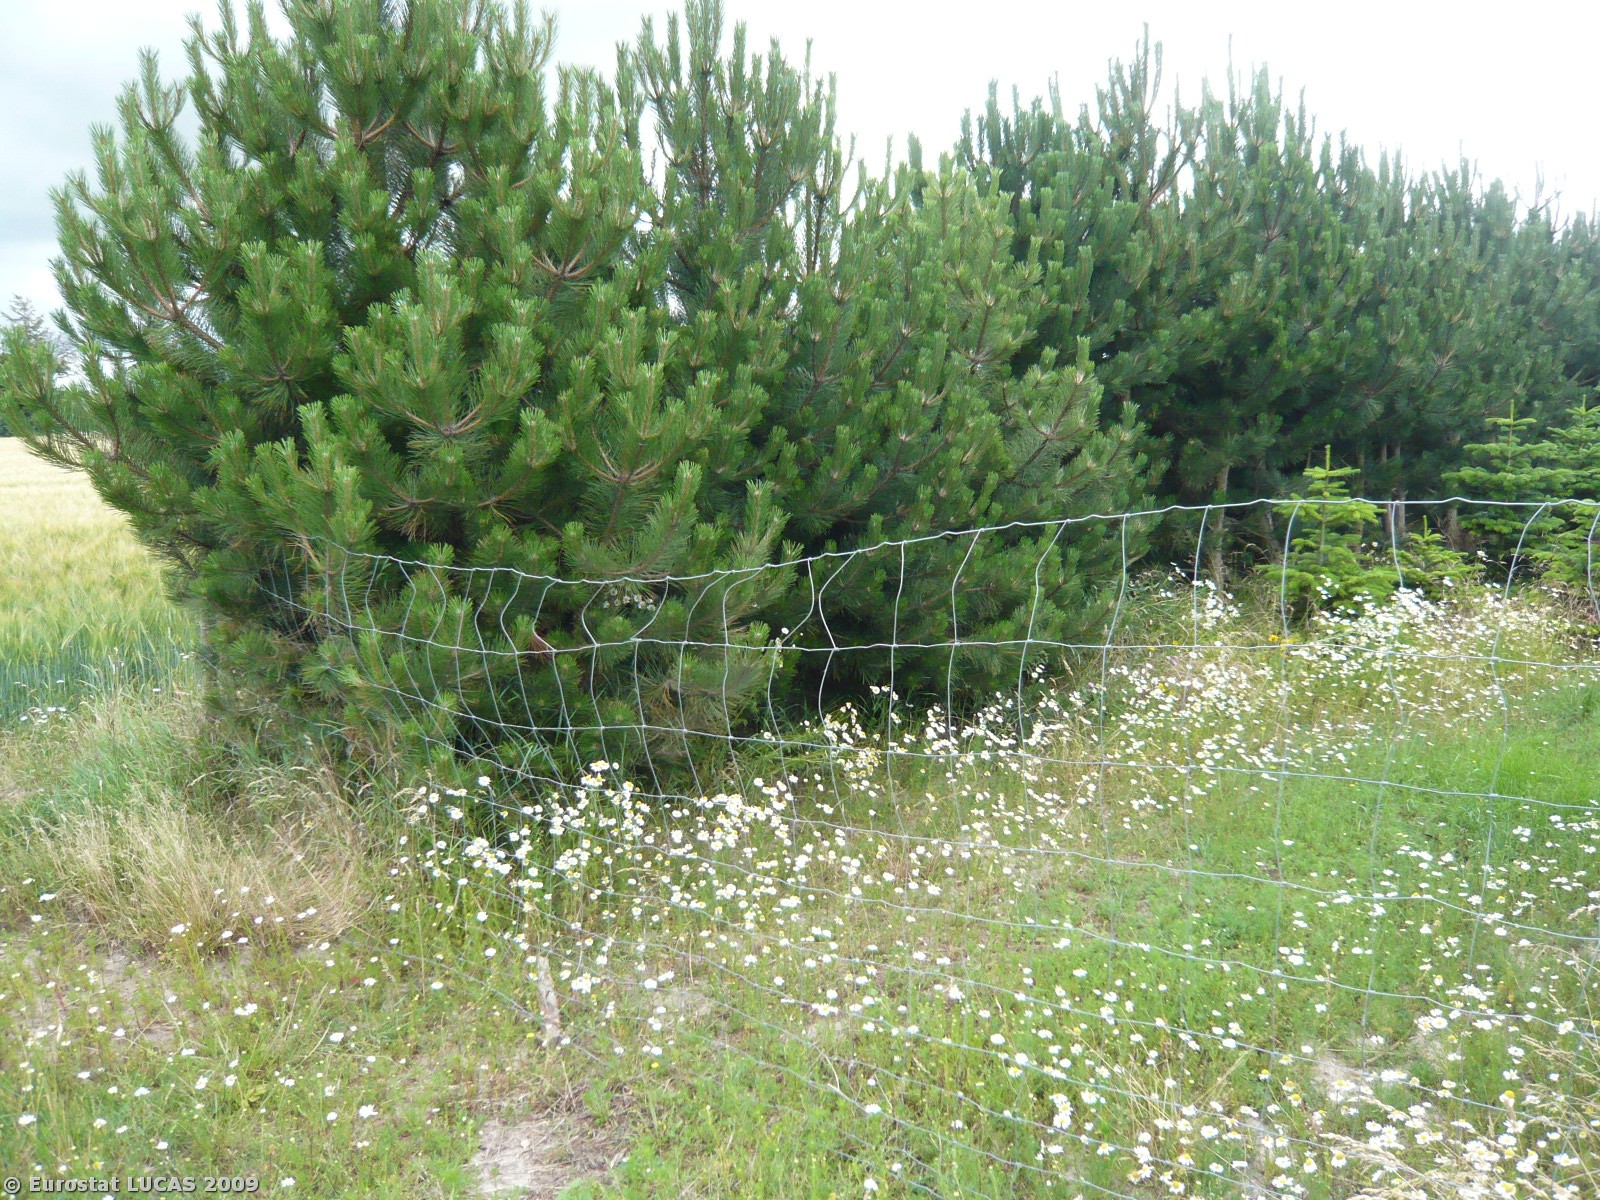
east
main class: Cropland
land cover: Rape and turnip rape
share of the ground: > 75 %
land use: Agriculture (excluding fallow land and kitchen gardens)
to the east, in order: Rape and turnip rape; Fences; Coniferous woodland; Fences; Barley; Grassland without tree/shrub cover; Ditches and canals; Paved roads, cycling and walking lanes; Tracks
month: July
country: DK
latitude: 55.4090
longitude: 11.2151
